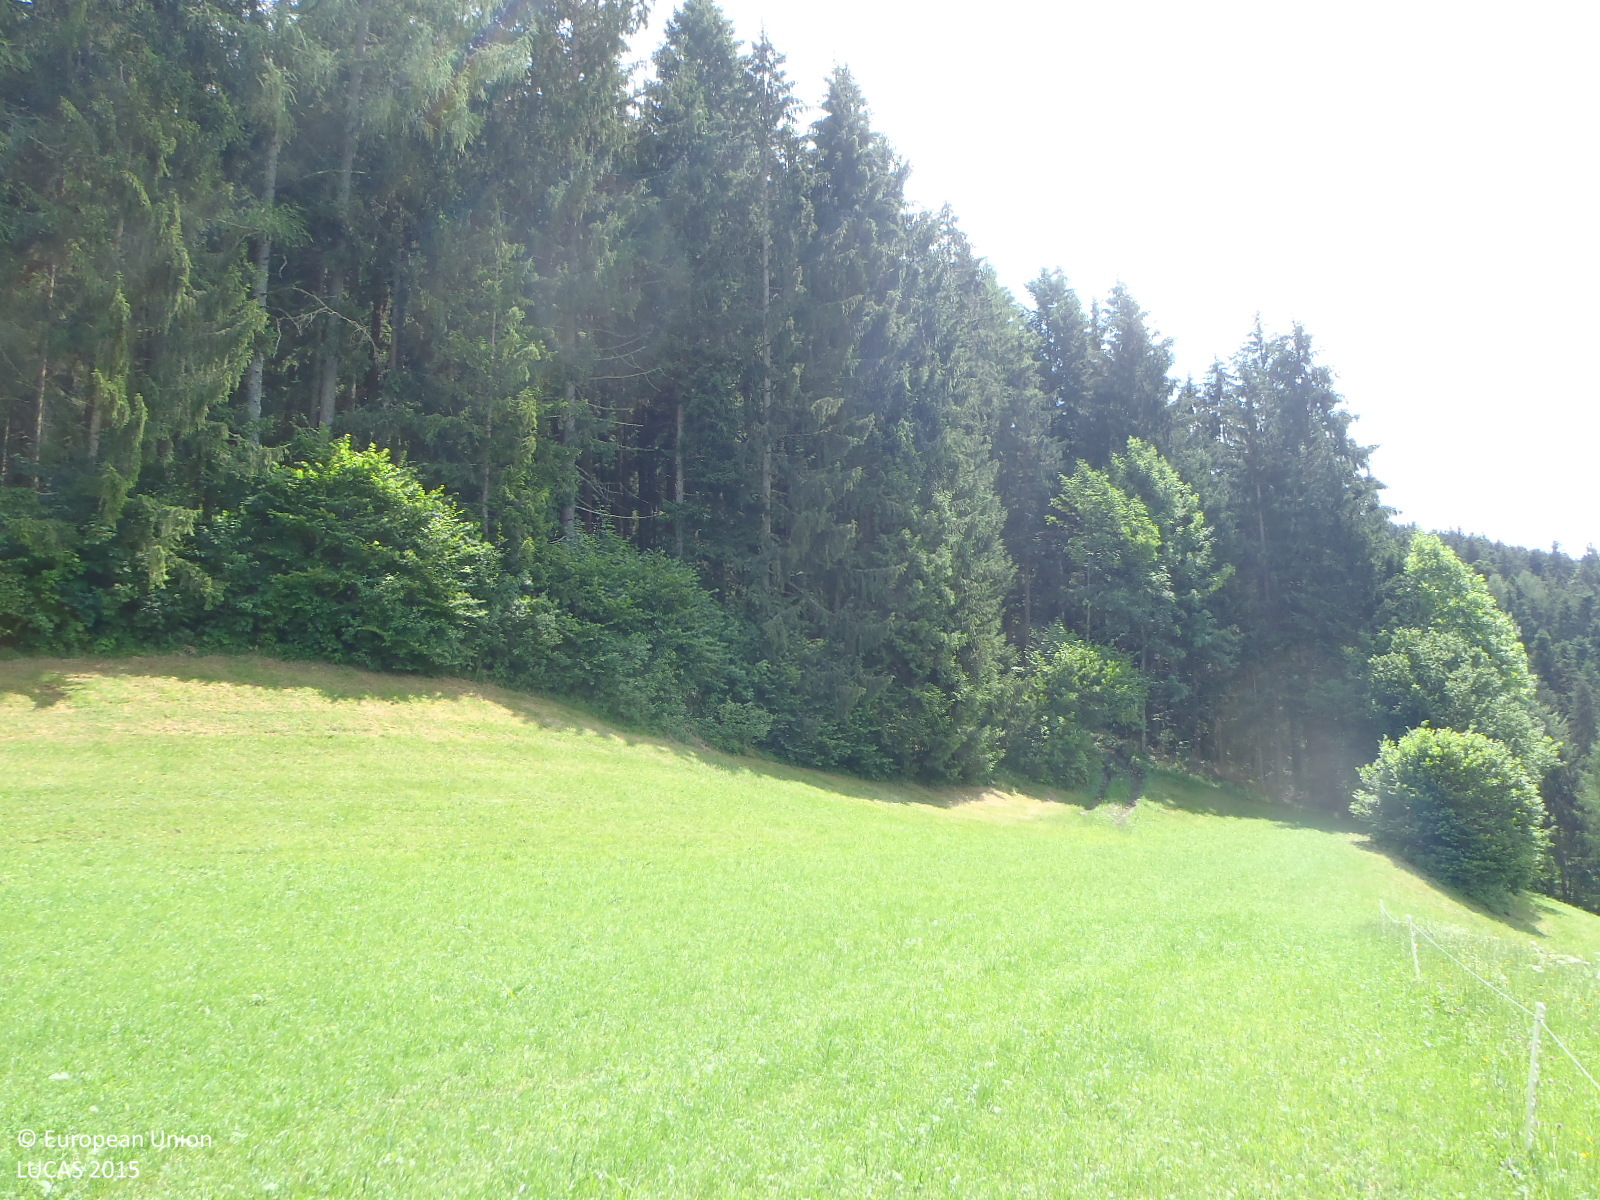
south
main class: Grassland
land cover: Grassland without tree/shrub cover
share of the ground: > 75 %
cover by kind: herbaceous plants 100 %
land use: Agriculture (excluding fallow land and kitchen gardens)
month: July
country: AT
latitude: 47.5362
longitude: 12.1638
